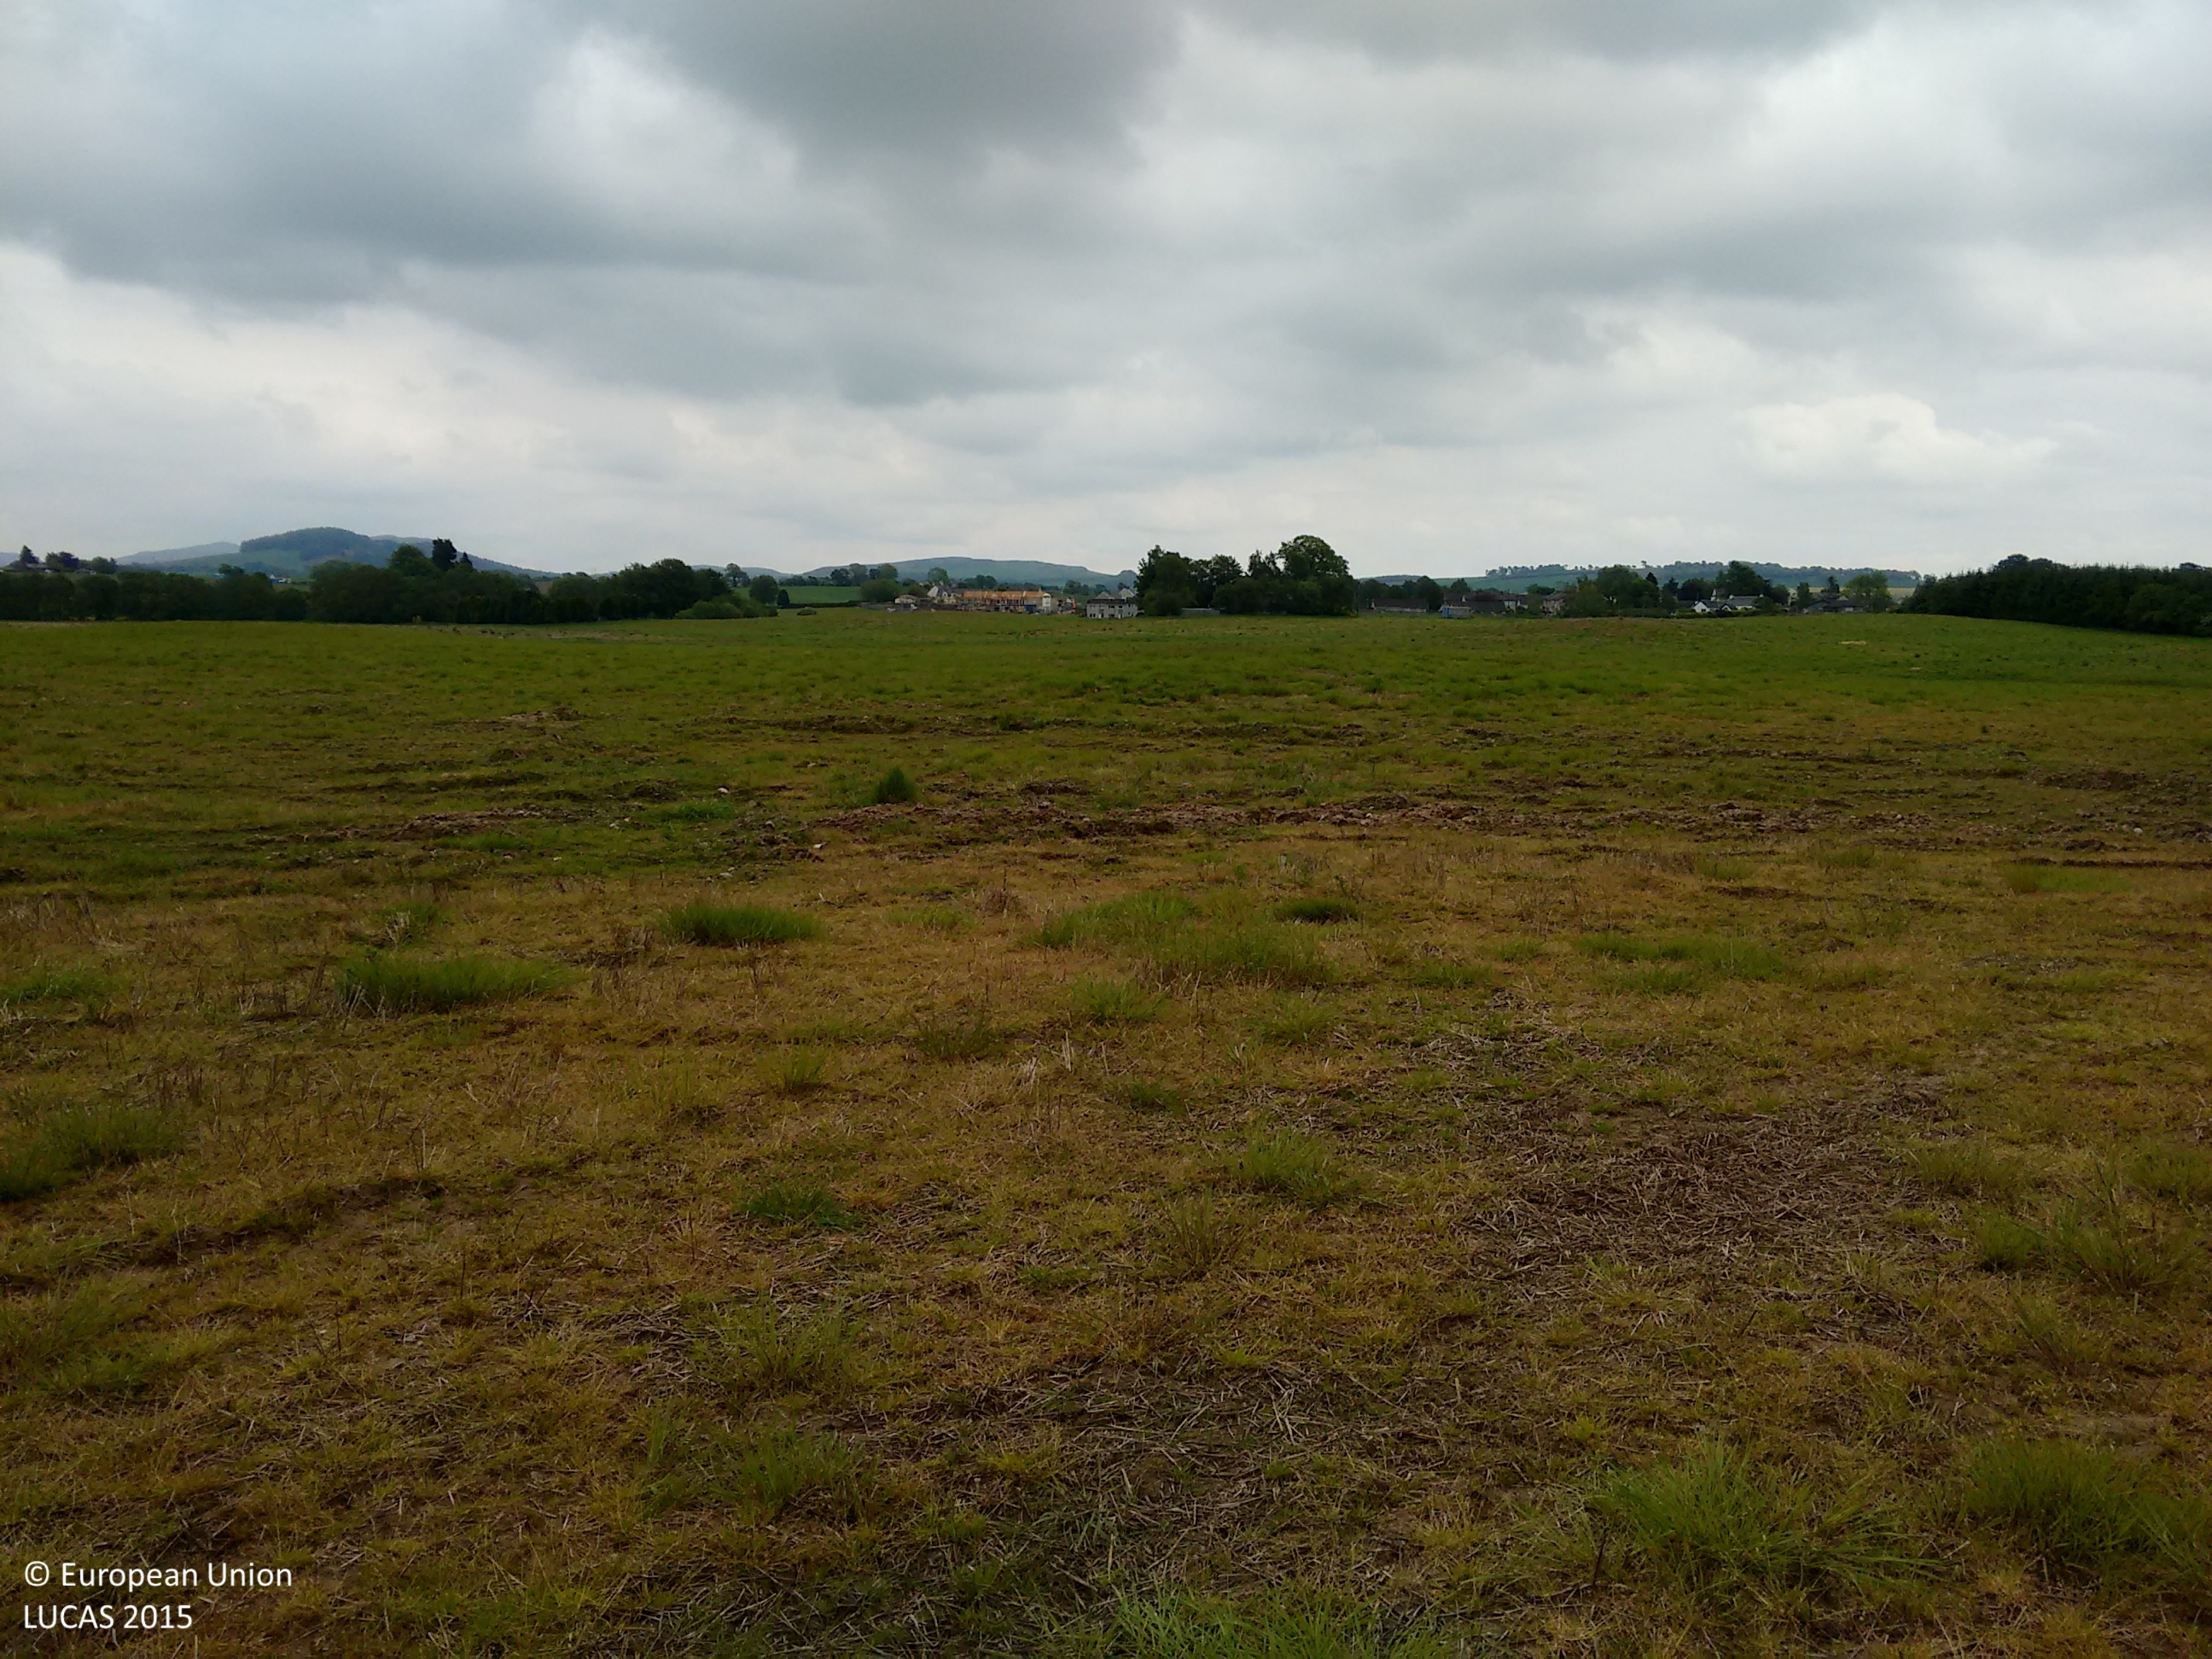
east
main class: Grassland
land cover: Spontaneously vegetated surfaces
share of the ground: > 75 %
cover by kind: herbaceous plants 85 %, unconsolidated bare surface 15 %
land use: Fallow land
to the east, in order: Spontaneously vegetated surfaces; Grassland without tree/shrub cover
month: June
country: GB
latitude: 56.4524
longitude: -3.3609
